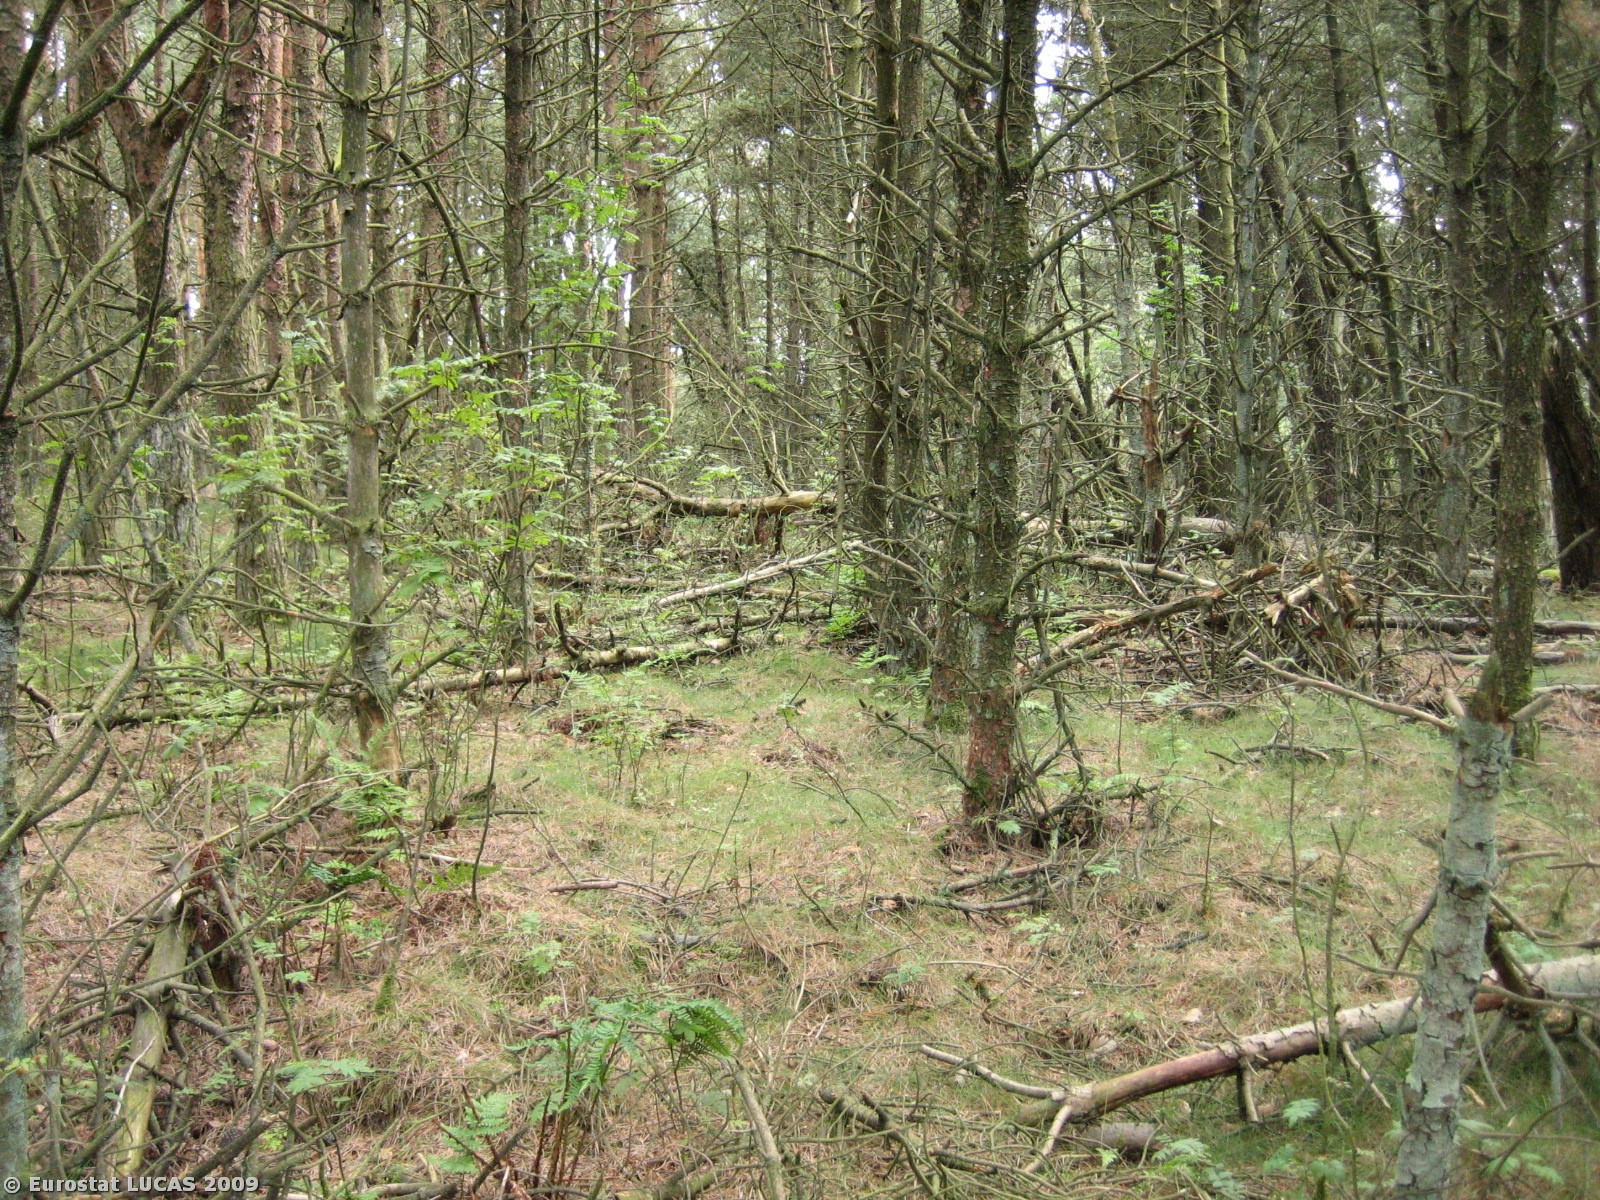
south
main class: Woodland
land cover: Coniferous woodland
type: hemiboreal forest and nemoral coniferous forest and mixed broadleaved-coniferous forest
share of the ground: > 75 %
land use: Forestry
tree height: > 5 m
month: July
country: DK
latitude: 55.7261
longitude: 8.2343
